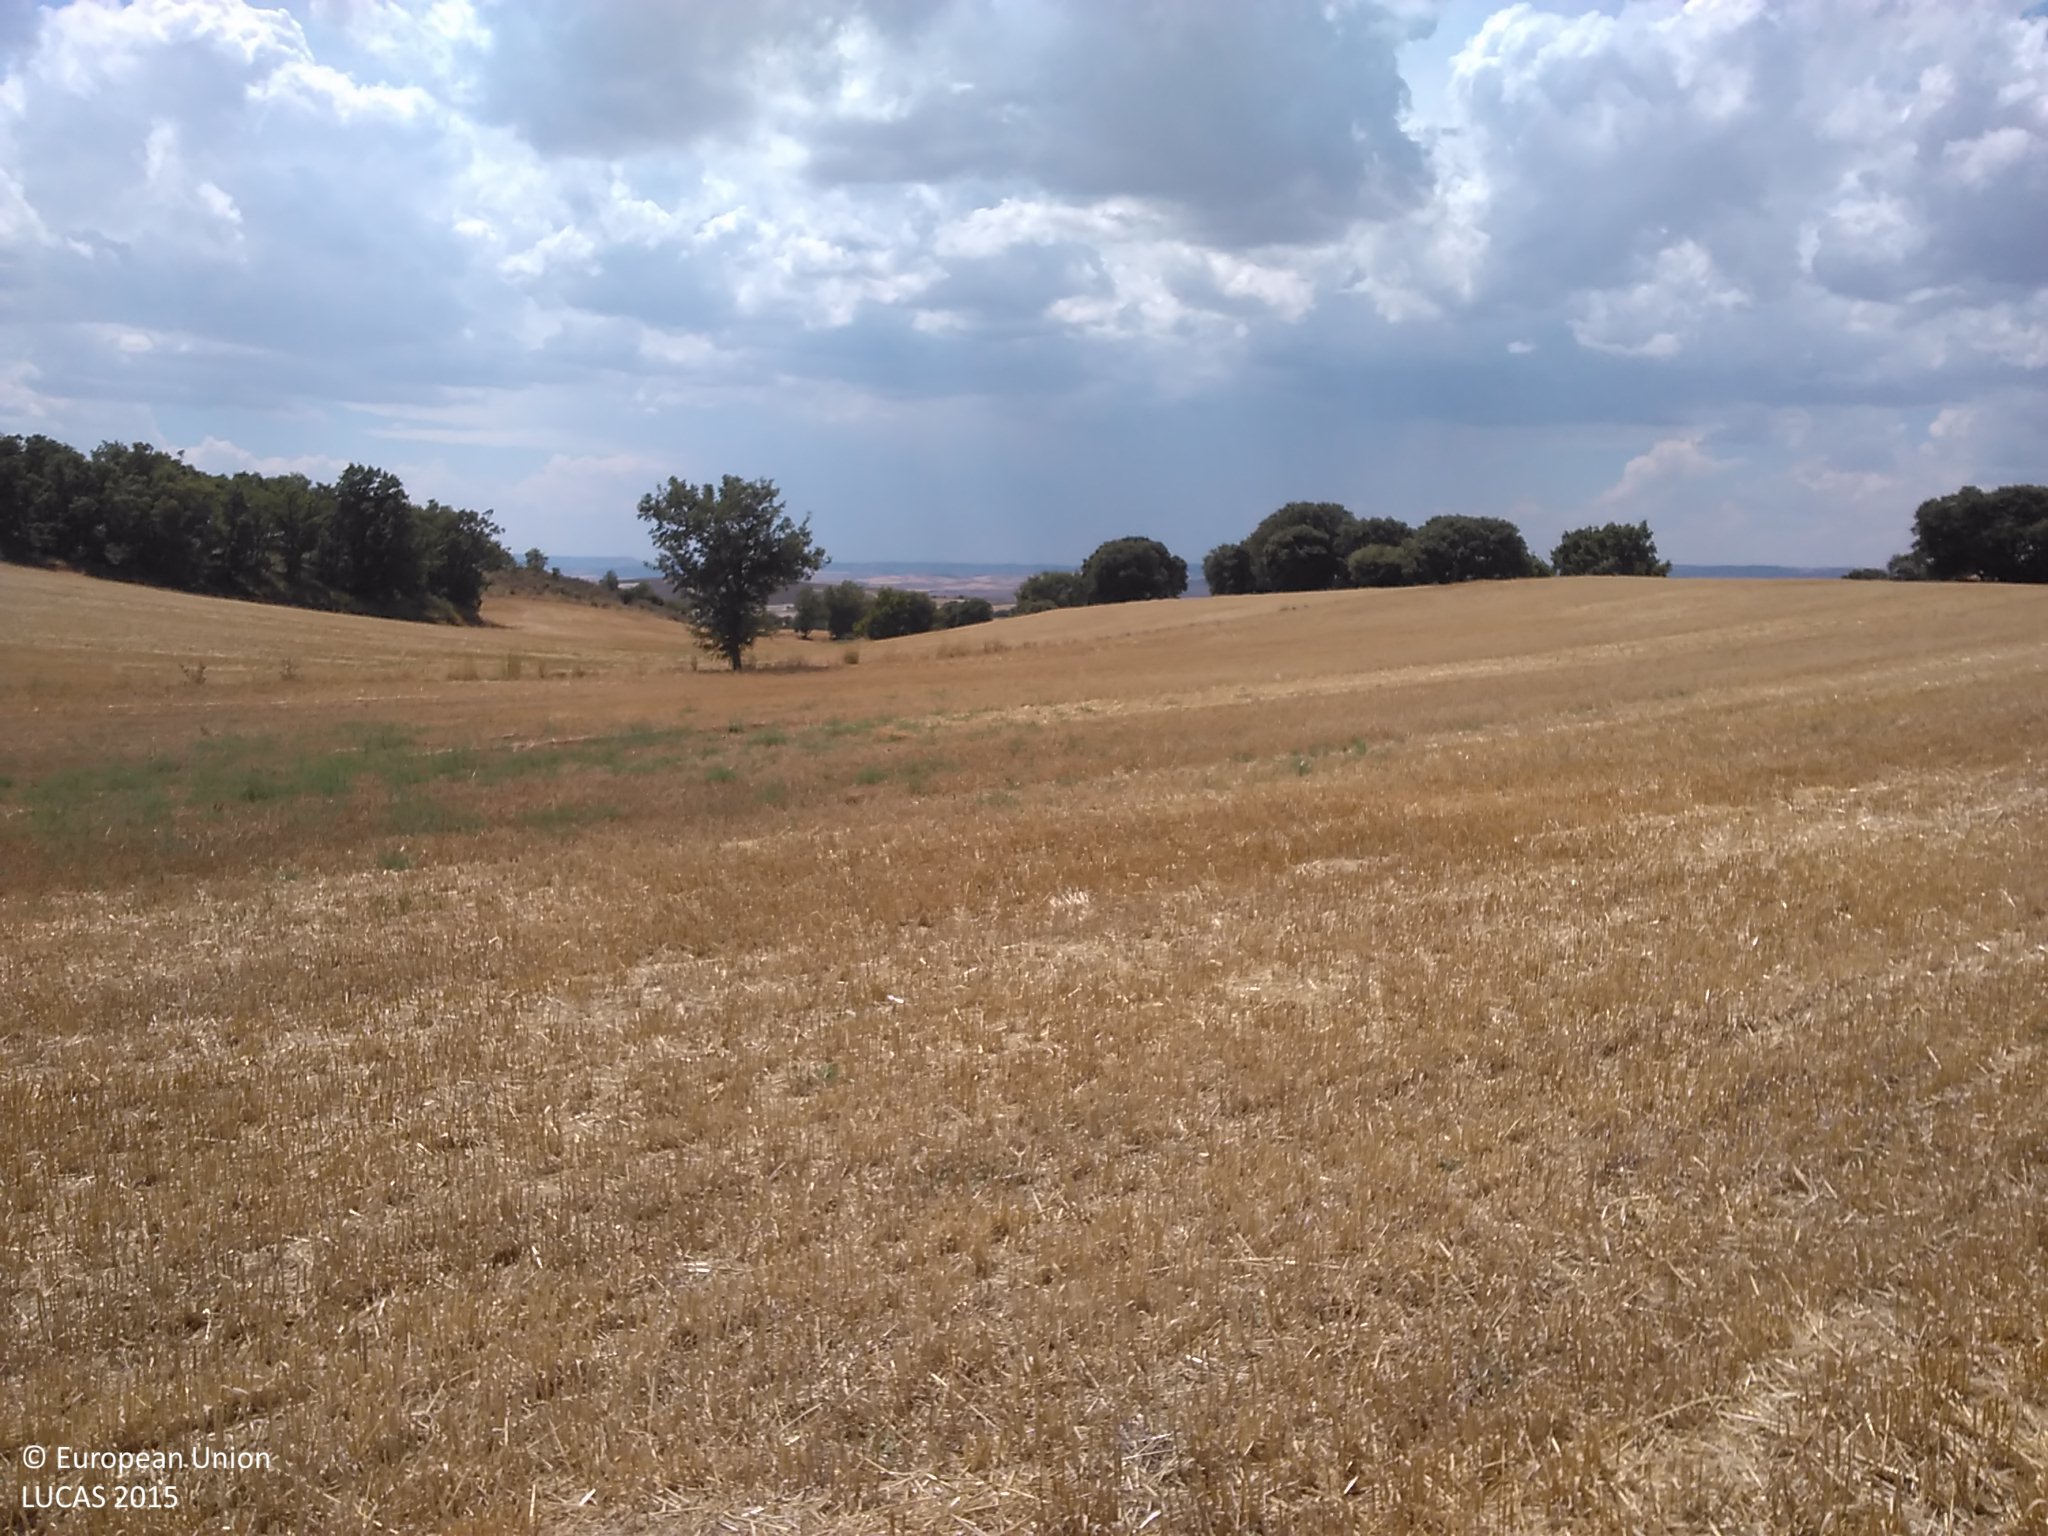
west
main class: Cropland
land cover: Barley
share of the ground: < 10 %
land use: Agriculture (excluding fallow land and kitchen gardens)
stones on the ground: < 10 %
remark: Harvested field
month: July
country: ES
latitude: 41.4532
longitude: -2.0852
